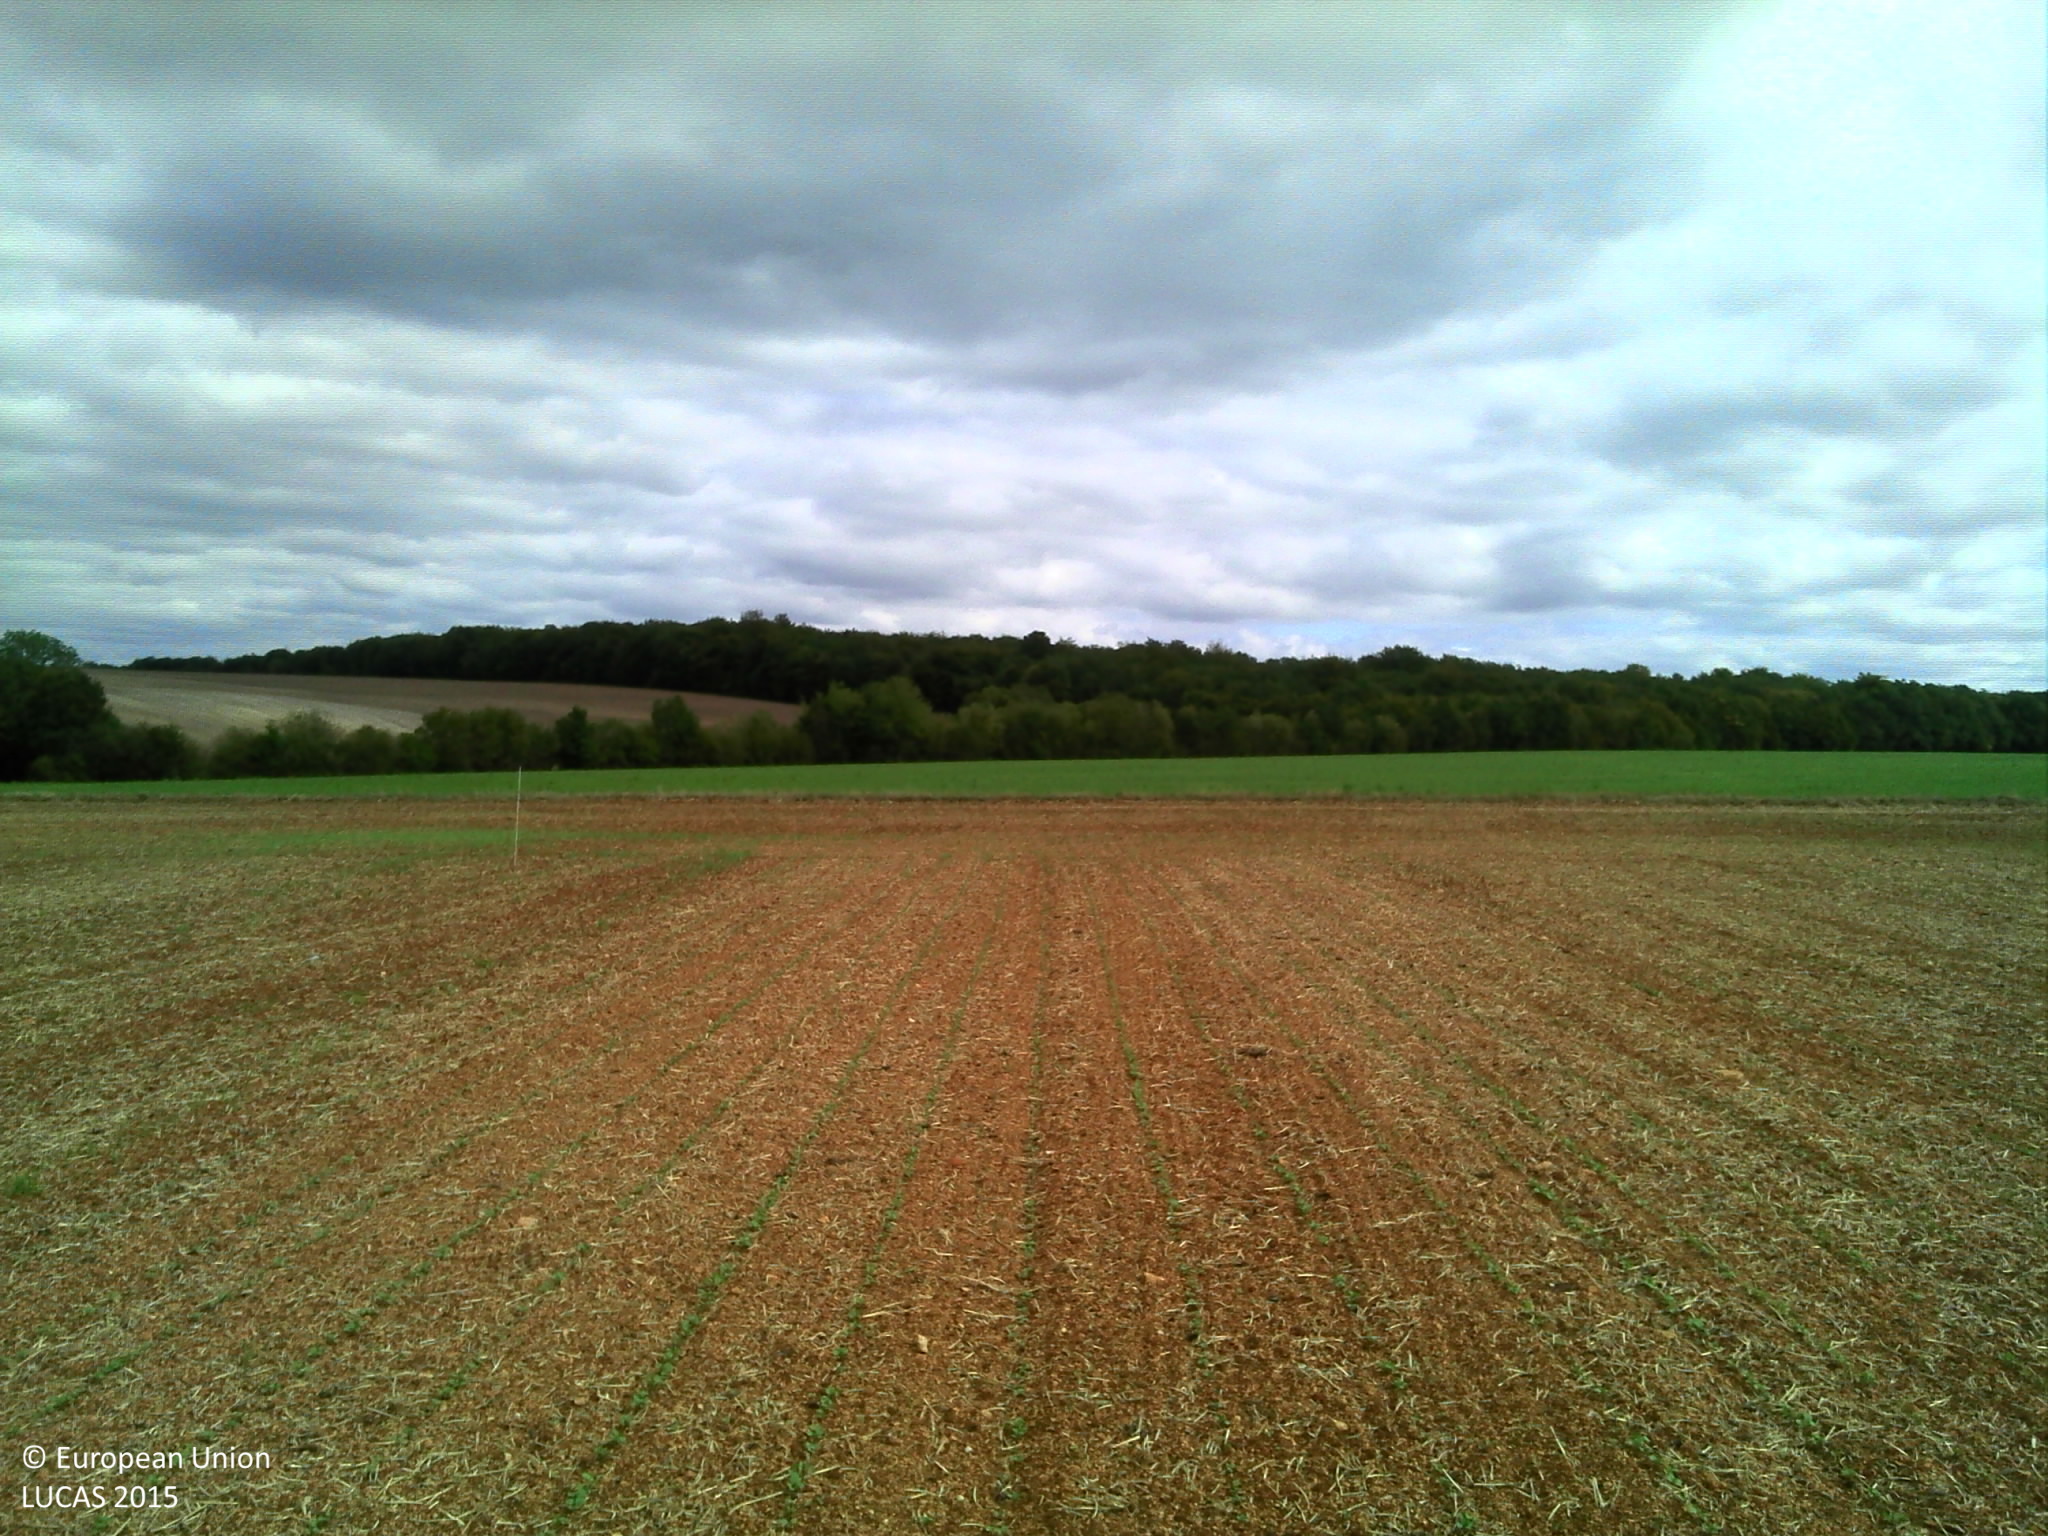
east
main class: Cropland
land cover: Barley
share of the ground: 10 - 25 %
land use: Agriculture (excluding fallow land and kitchen gardens)
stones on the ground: 10 - 25 %
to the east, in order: Barley; Grass margins; Tracks; Grass margins; Barley; Grass margins; Managed hedges; Grass margins; Rape and turnip rape
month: September
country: FR
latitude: 47.5382
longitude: 4.7254
